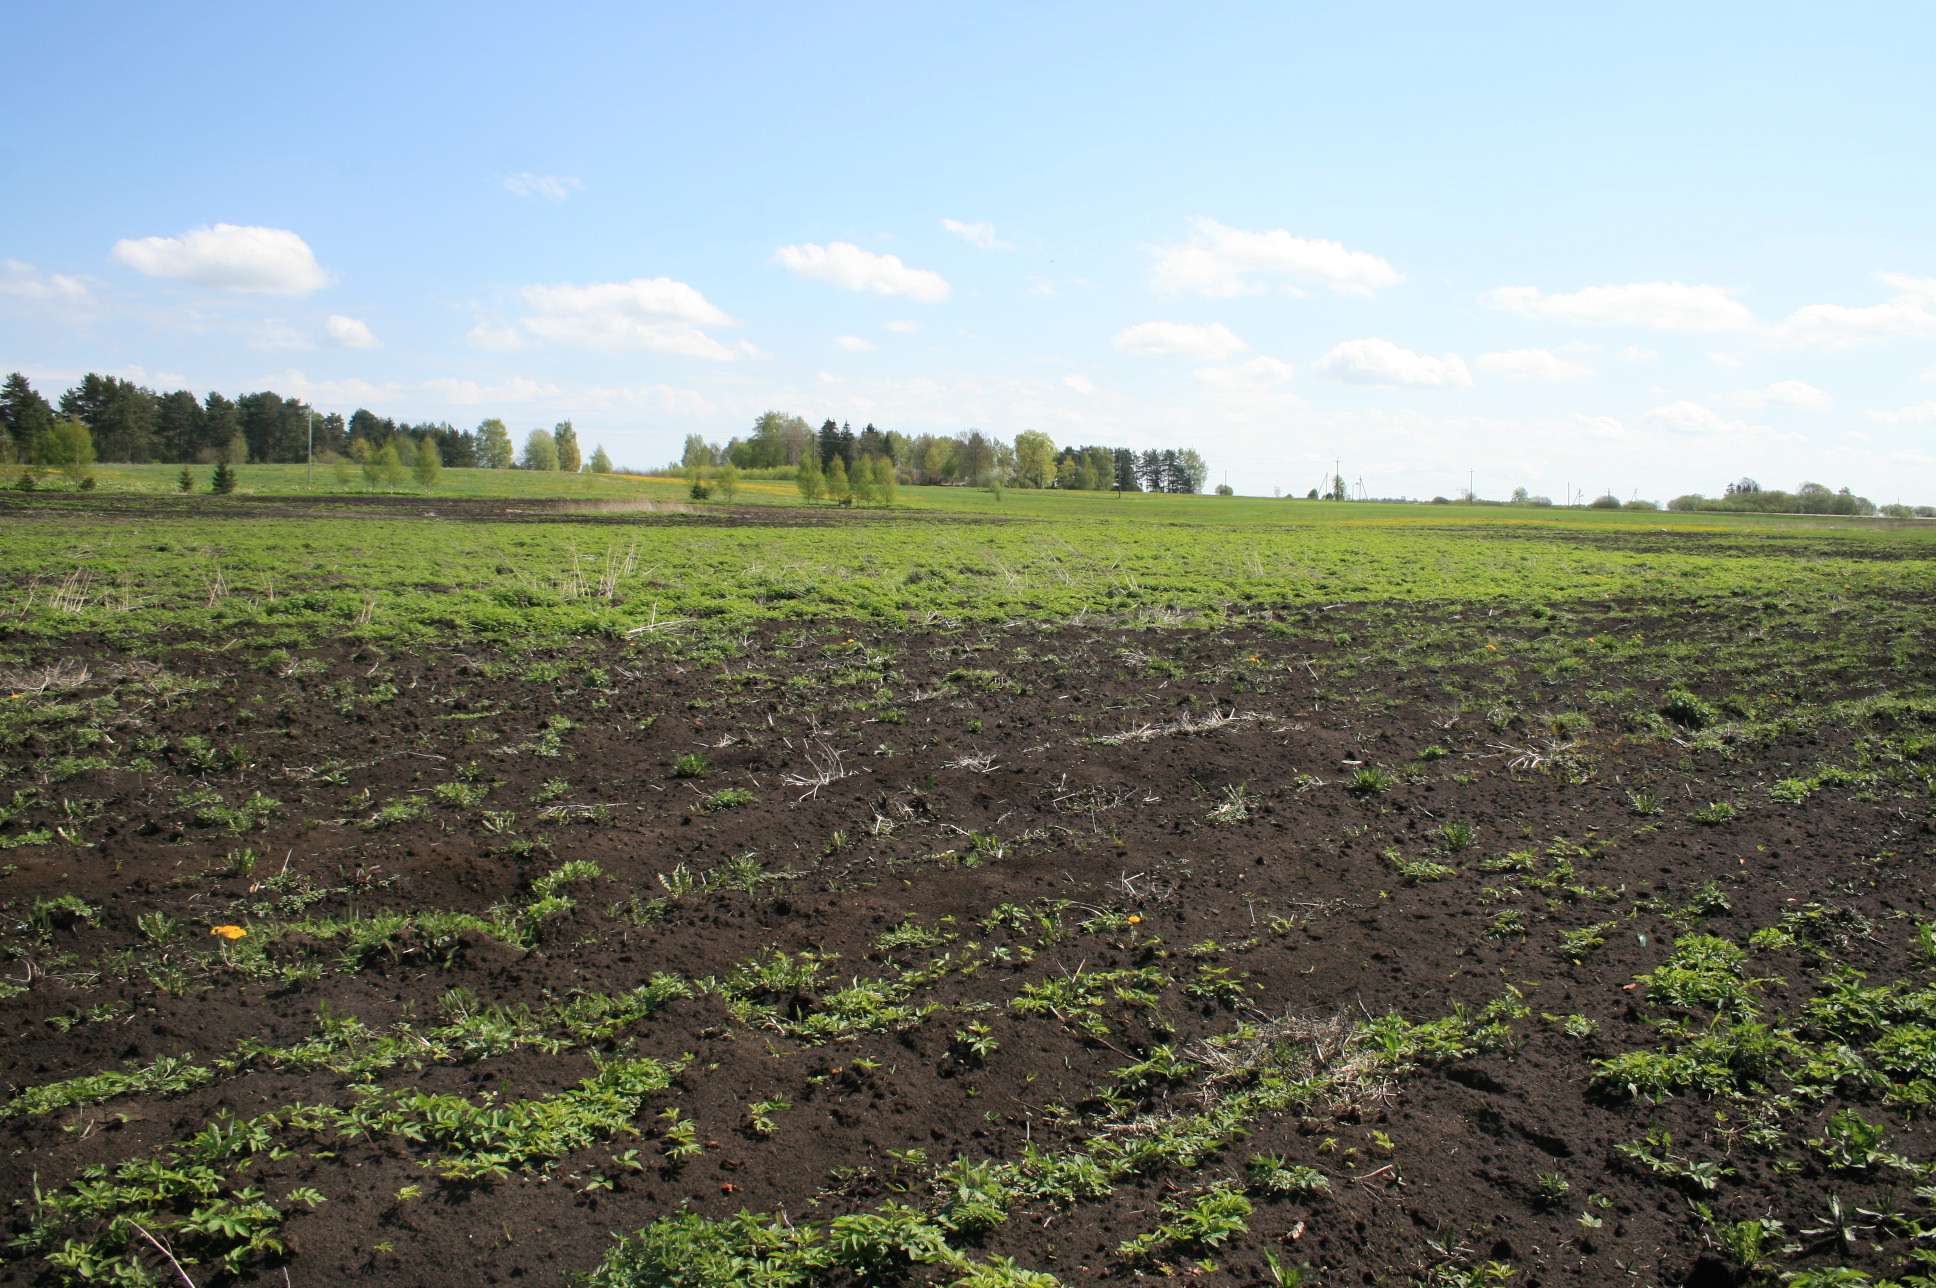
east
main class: Grassland
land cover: Spontaneously vegetated surfaces
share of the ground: 50 - 75 %
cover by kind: herbaceous plants 65 %, unconsolidated bare surface 35 %
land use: Fallow land
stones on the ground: < 10 %
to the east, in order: Spontaneously vegetated surfaces; Other bare soil; Lines of trees; Grassland without tree/shrub cover; Electric lines; Grassland without tree/shrub cover
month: May
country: LT
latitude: 56.2992
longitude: 21.5660
